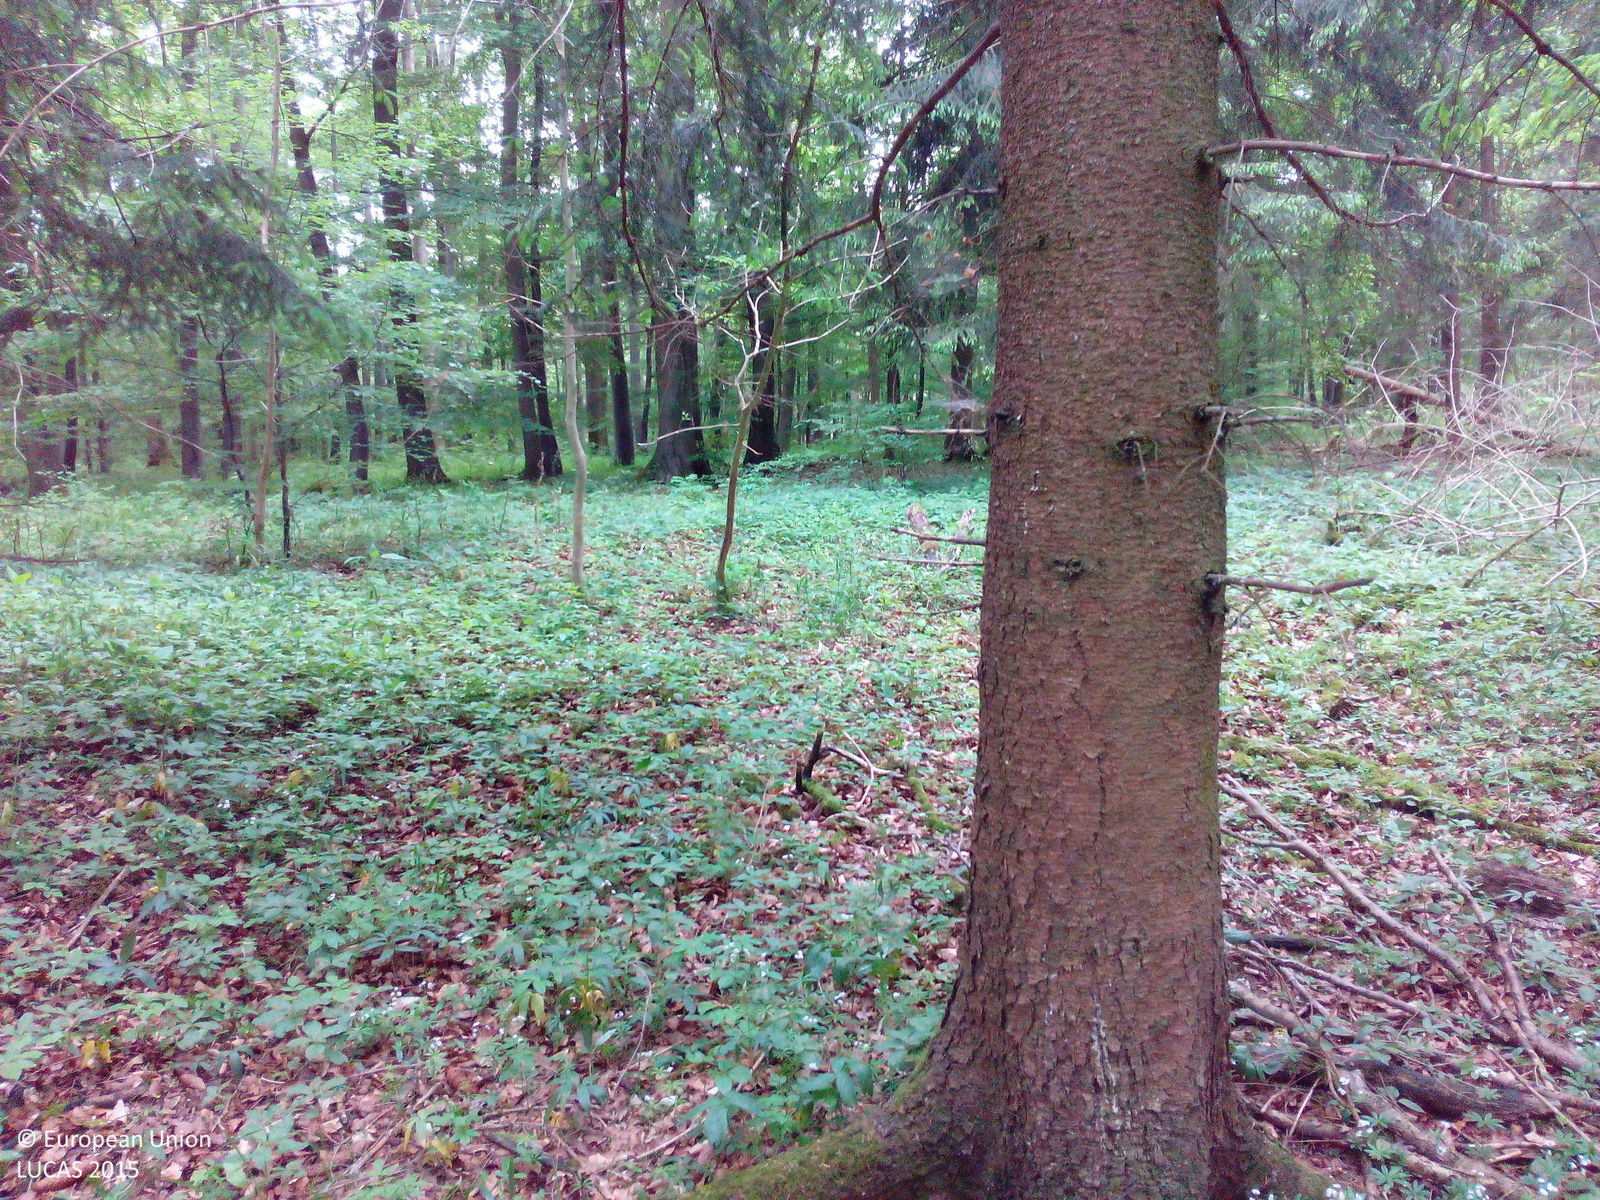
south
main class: Woodland
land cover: Spruce dominated coniferous woodland
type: hemiboreal forest and nemoral coniferous forest and mixed broadleaved-coniferous forest
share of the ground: > 75 %
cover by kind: coniferous forest trees 80 %, broadleaved forest trees 15 %, shrubs 5 %
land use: Forestry
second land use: Amenities, museums, leisure
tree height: > 5 m
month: May
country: DE
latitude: 51.9820
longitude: 9.8981
